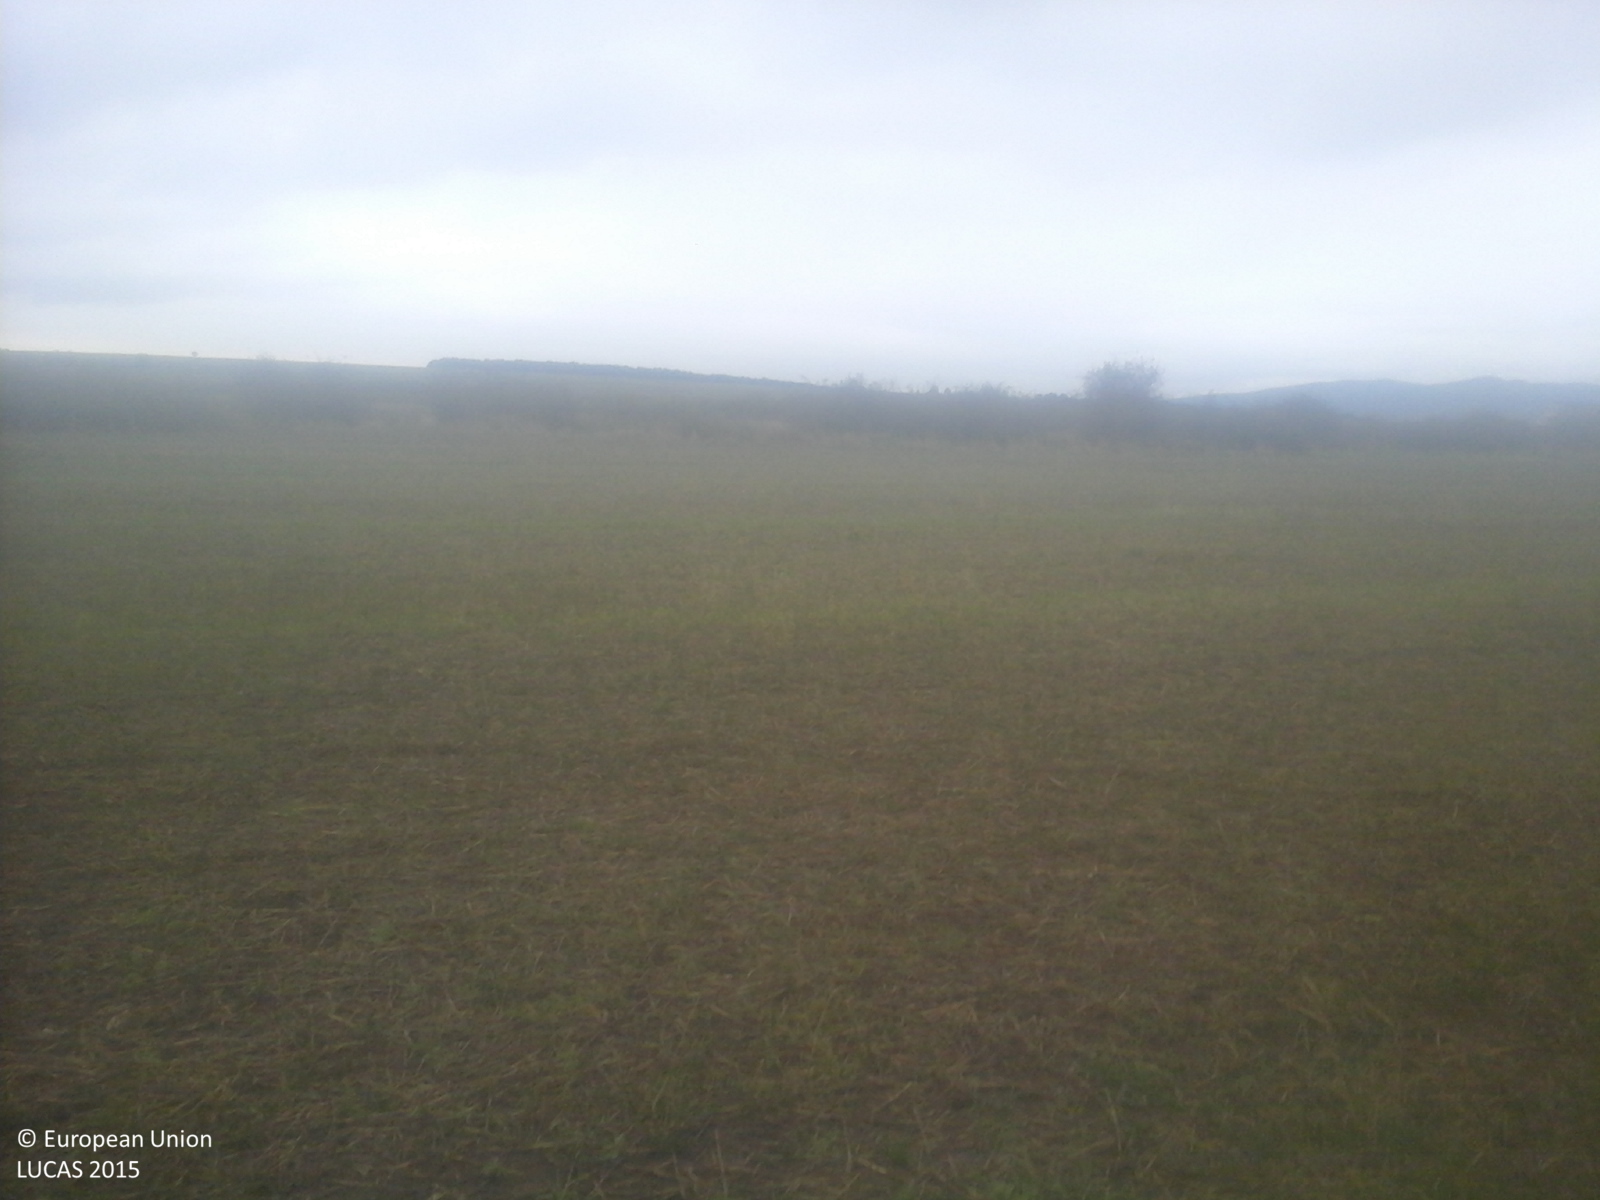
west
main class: Cropland
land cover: Common wheat
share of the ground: 25 - 50 %
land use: Agriculture (excluding fallow land and kitchen gardens)
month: September
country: RO
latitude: 45.9334
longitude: 23.4633
